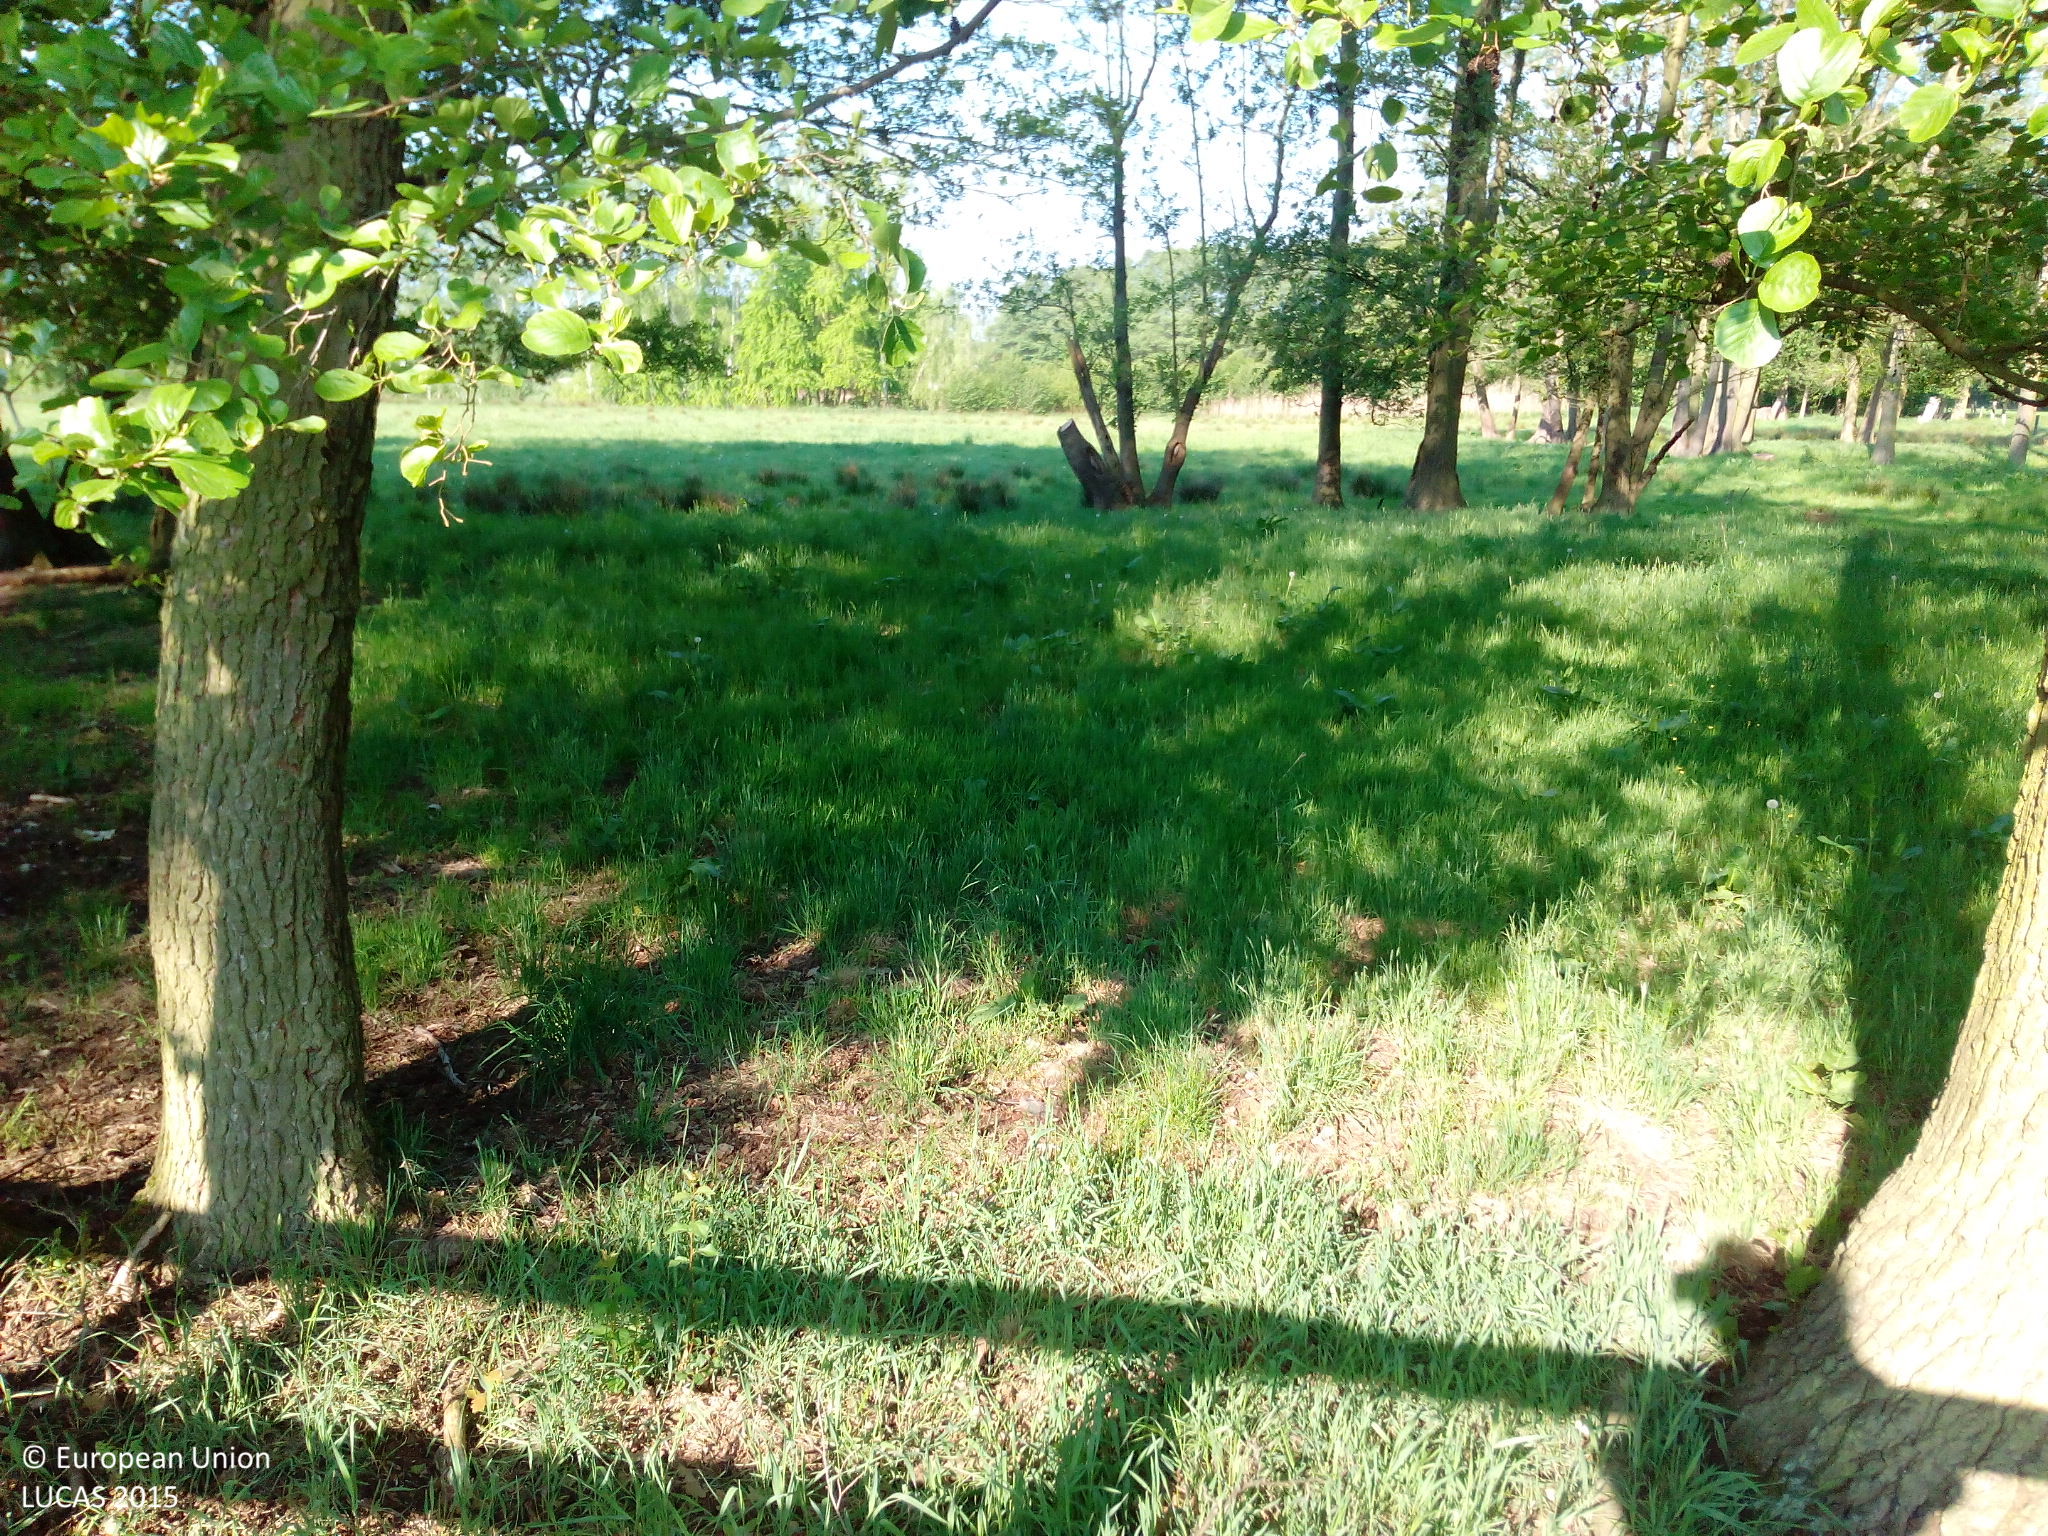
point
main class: Grassland
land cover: Grassland without tree/shrub cover
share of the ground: 50 - 75 %
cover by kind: herbaceous plants 100 %
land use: Agriculture (excluding fallow land and kitchen gardens)
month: May
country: DE
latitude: 52.0655
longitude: 13.1654
